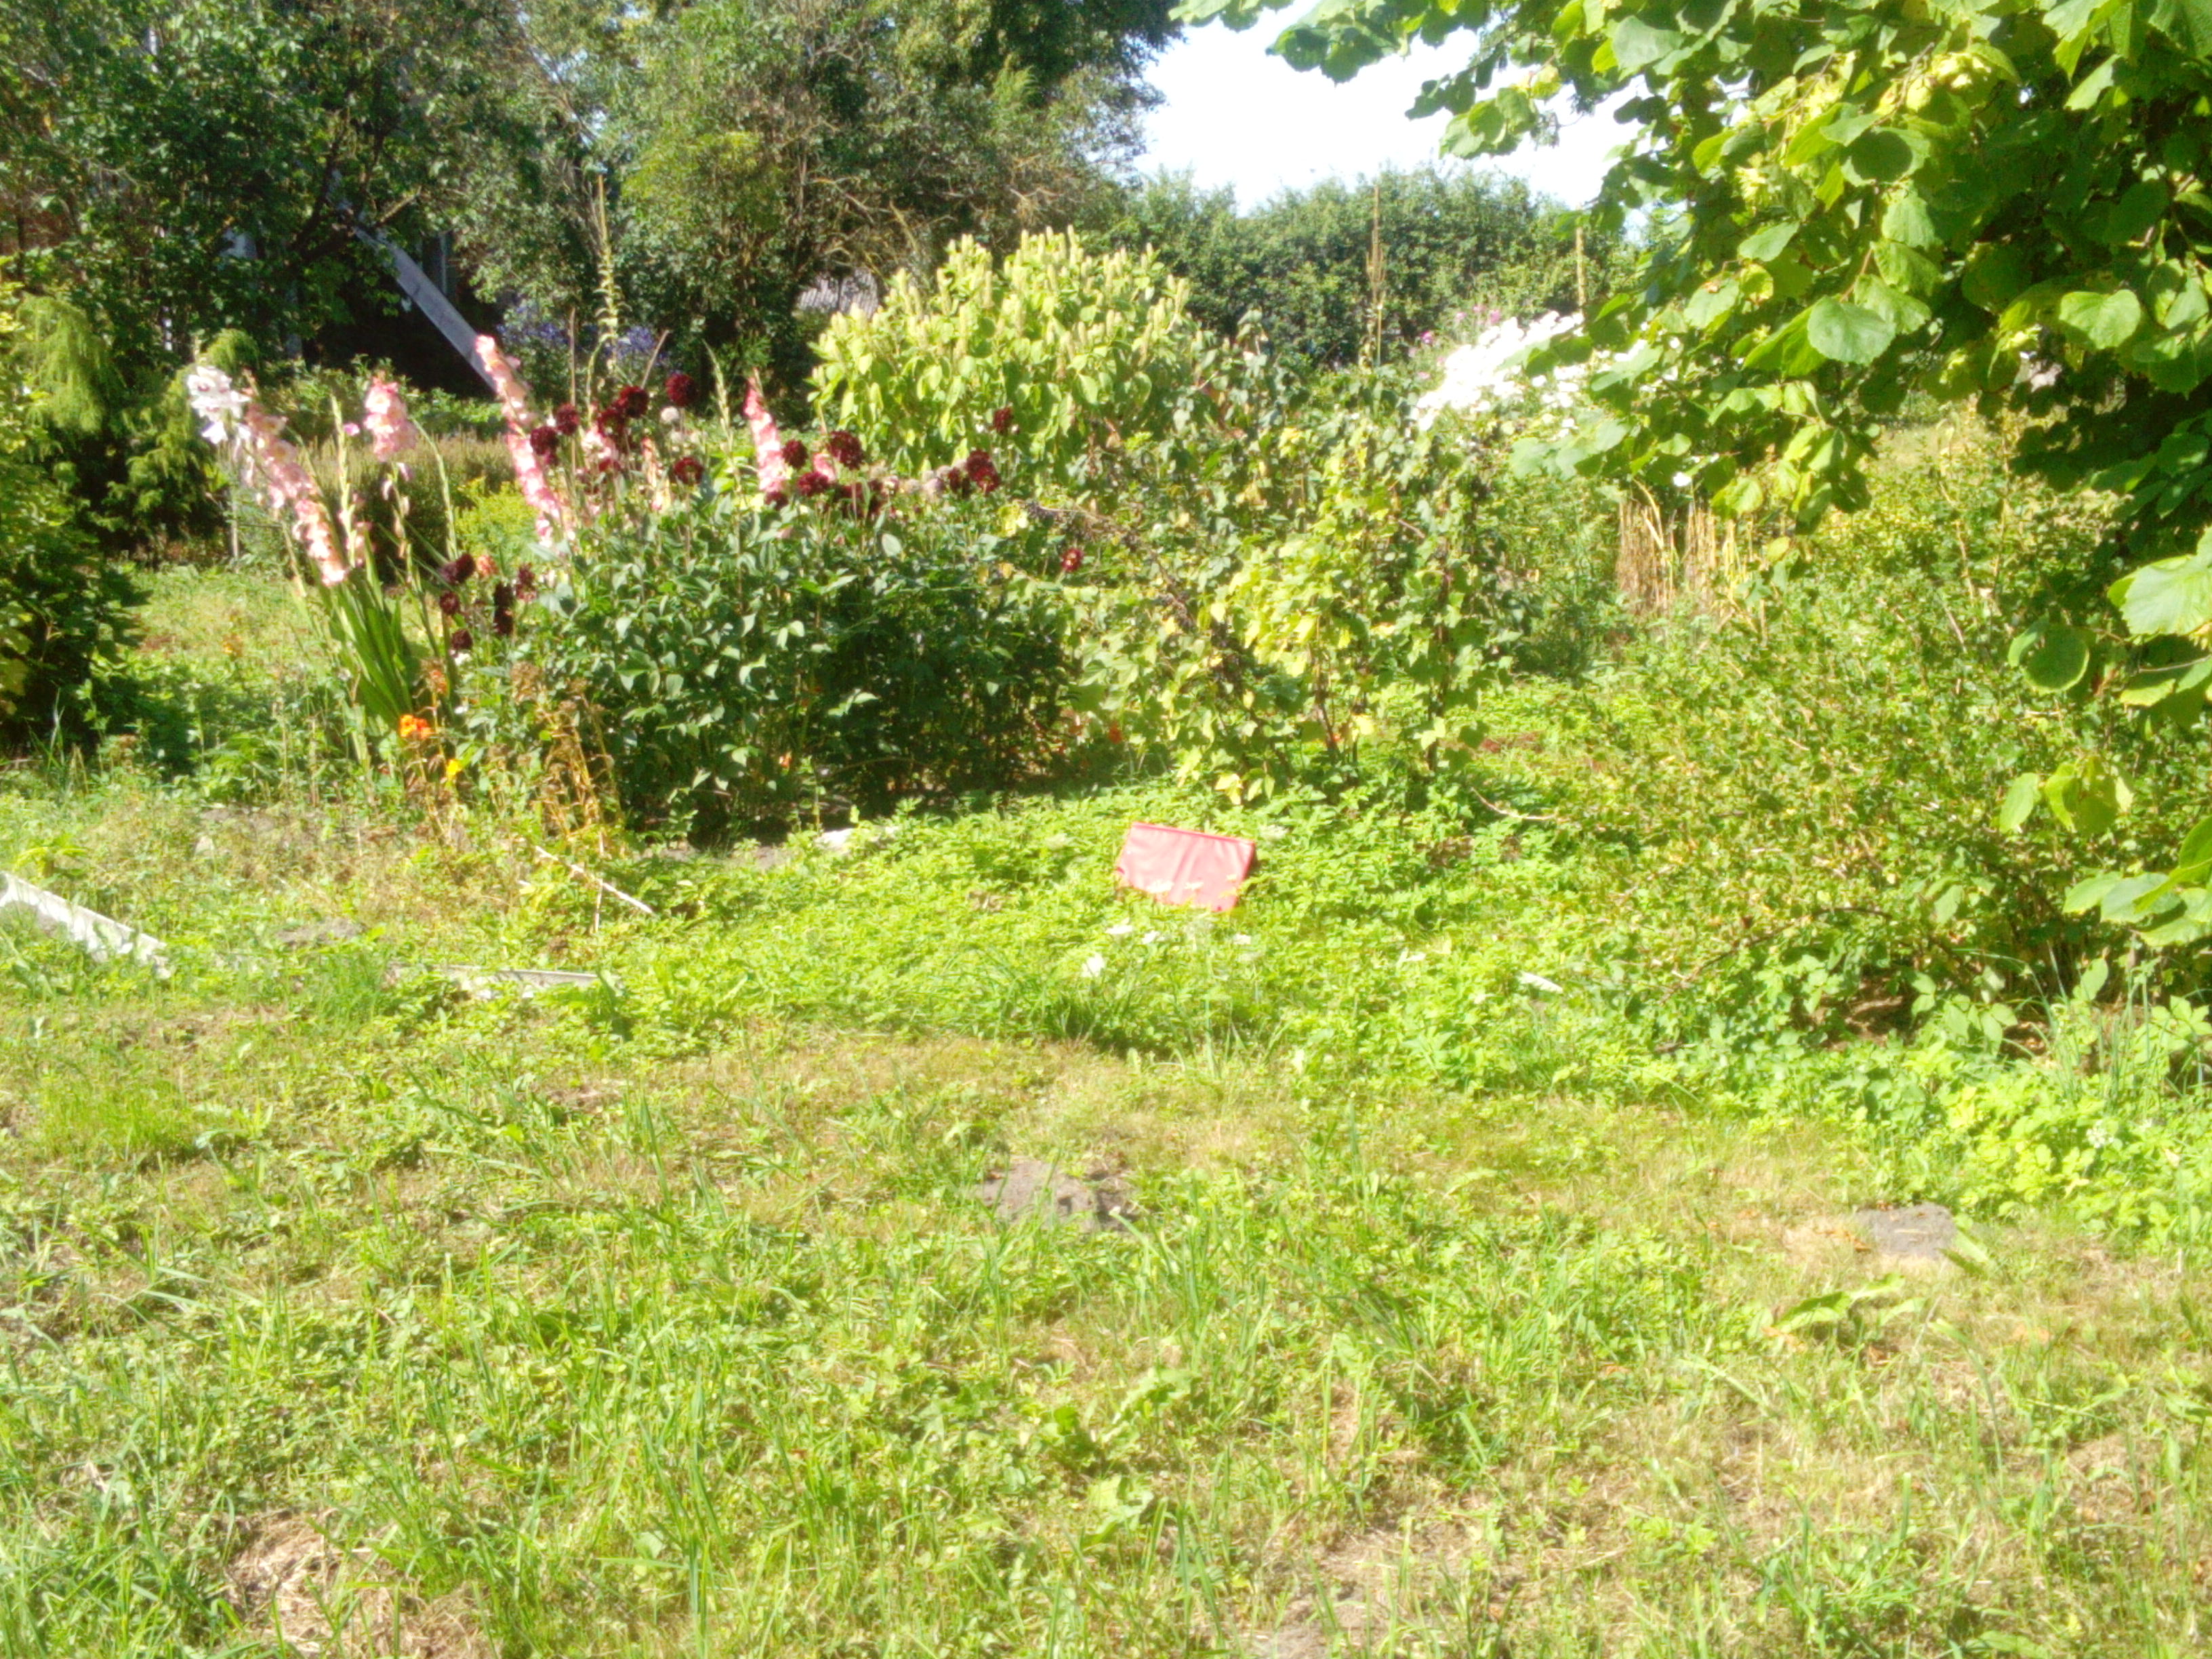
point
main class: Cropland
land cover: Apple fruit
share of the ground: 25 - 50 %
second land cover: Grassland without tree/shrub cover
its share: > 75 %
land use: Kitchen garden
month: August
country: LV
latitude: 56.6103
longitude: 21.1323
